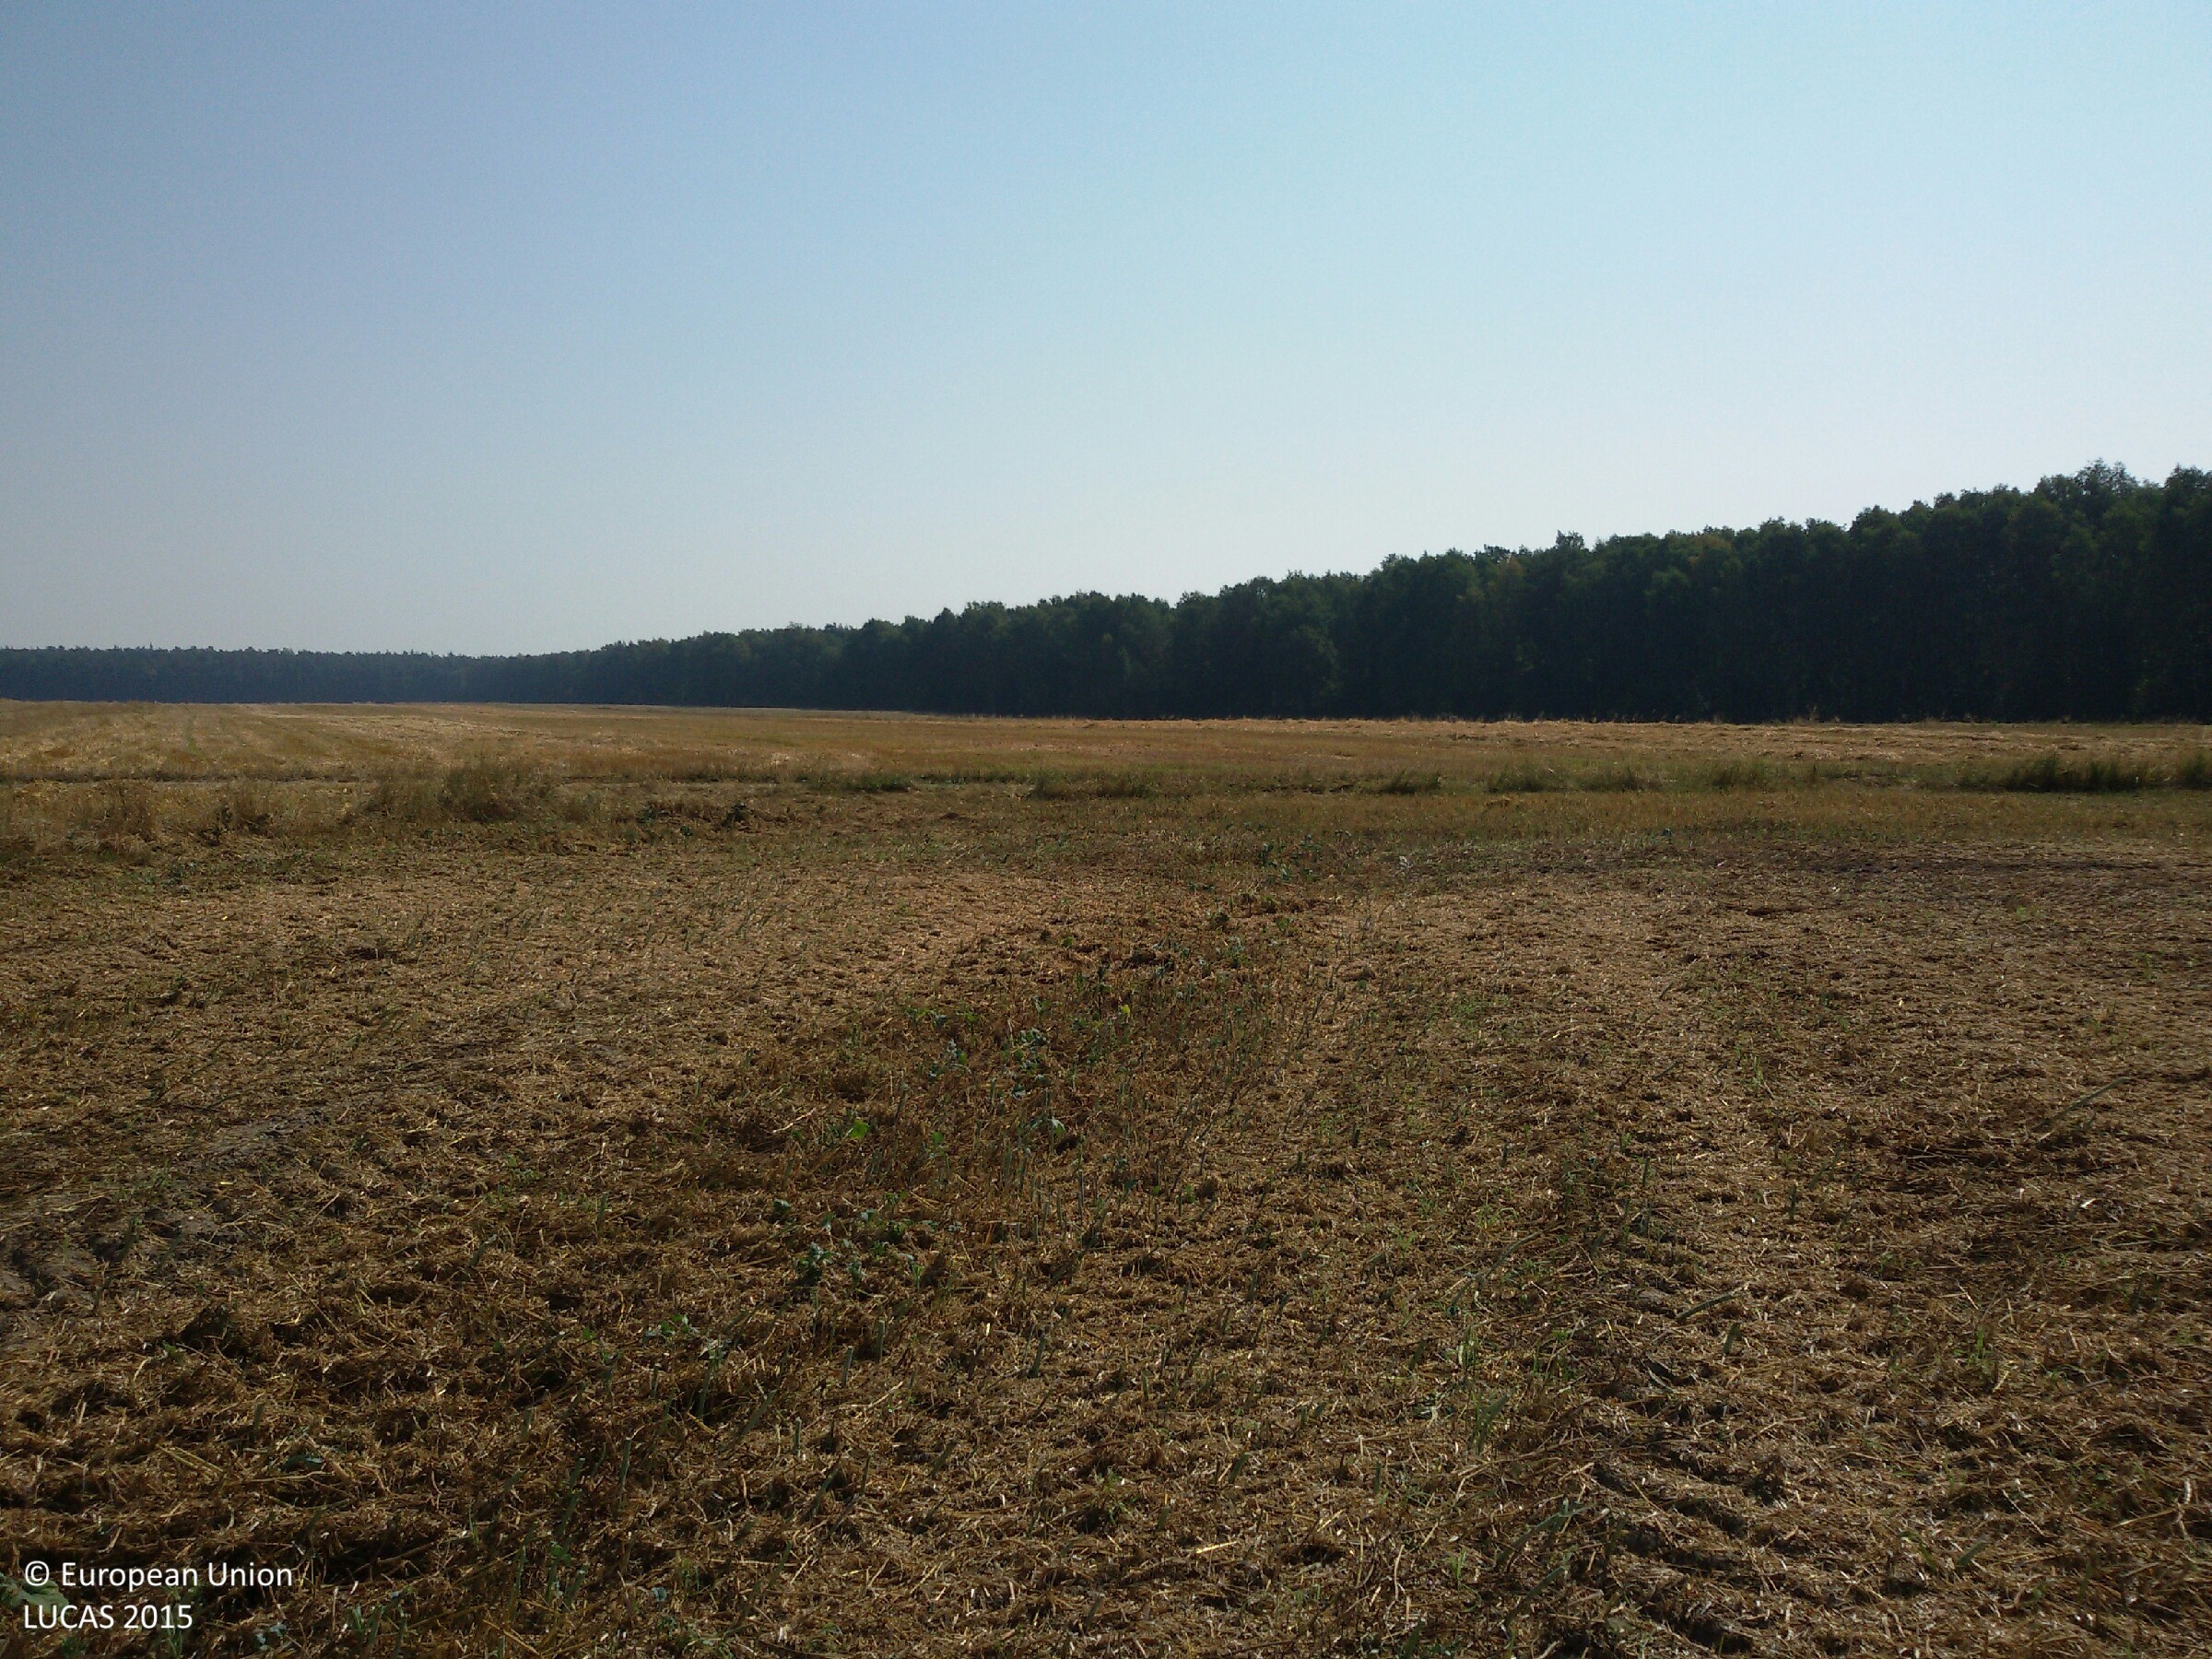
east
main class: Cropland
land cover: Barley
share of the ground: 50 - 75 %
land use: Agriculture (excluding fallow land and kitchen gardens)
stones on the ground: < 10 %
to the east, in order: Barley; Grass margins; Tracks; Grass margins; Common wheat; Oats; Rye; Mixed cereals for fodder; Common wheat
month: August
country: PL
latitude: 51.6763
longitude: 22.8418
